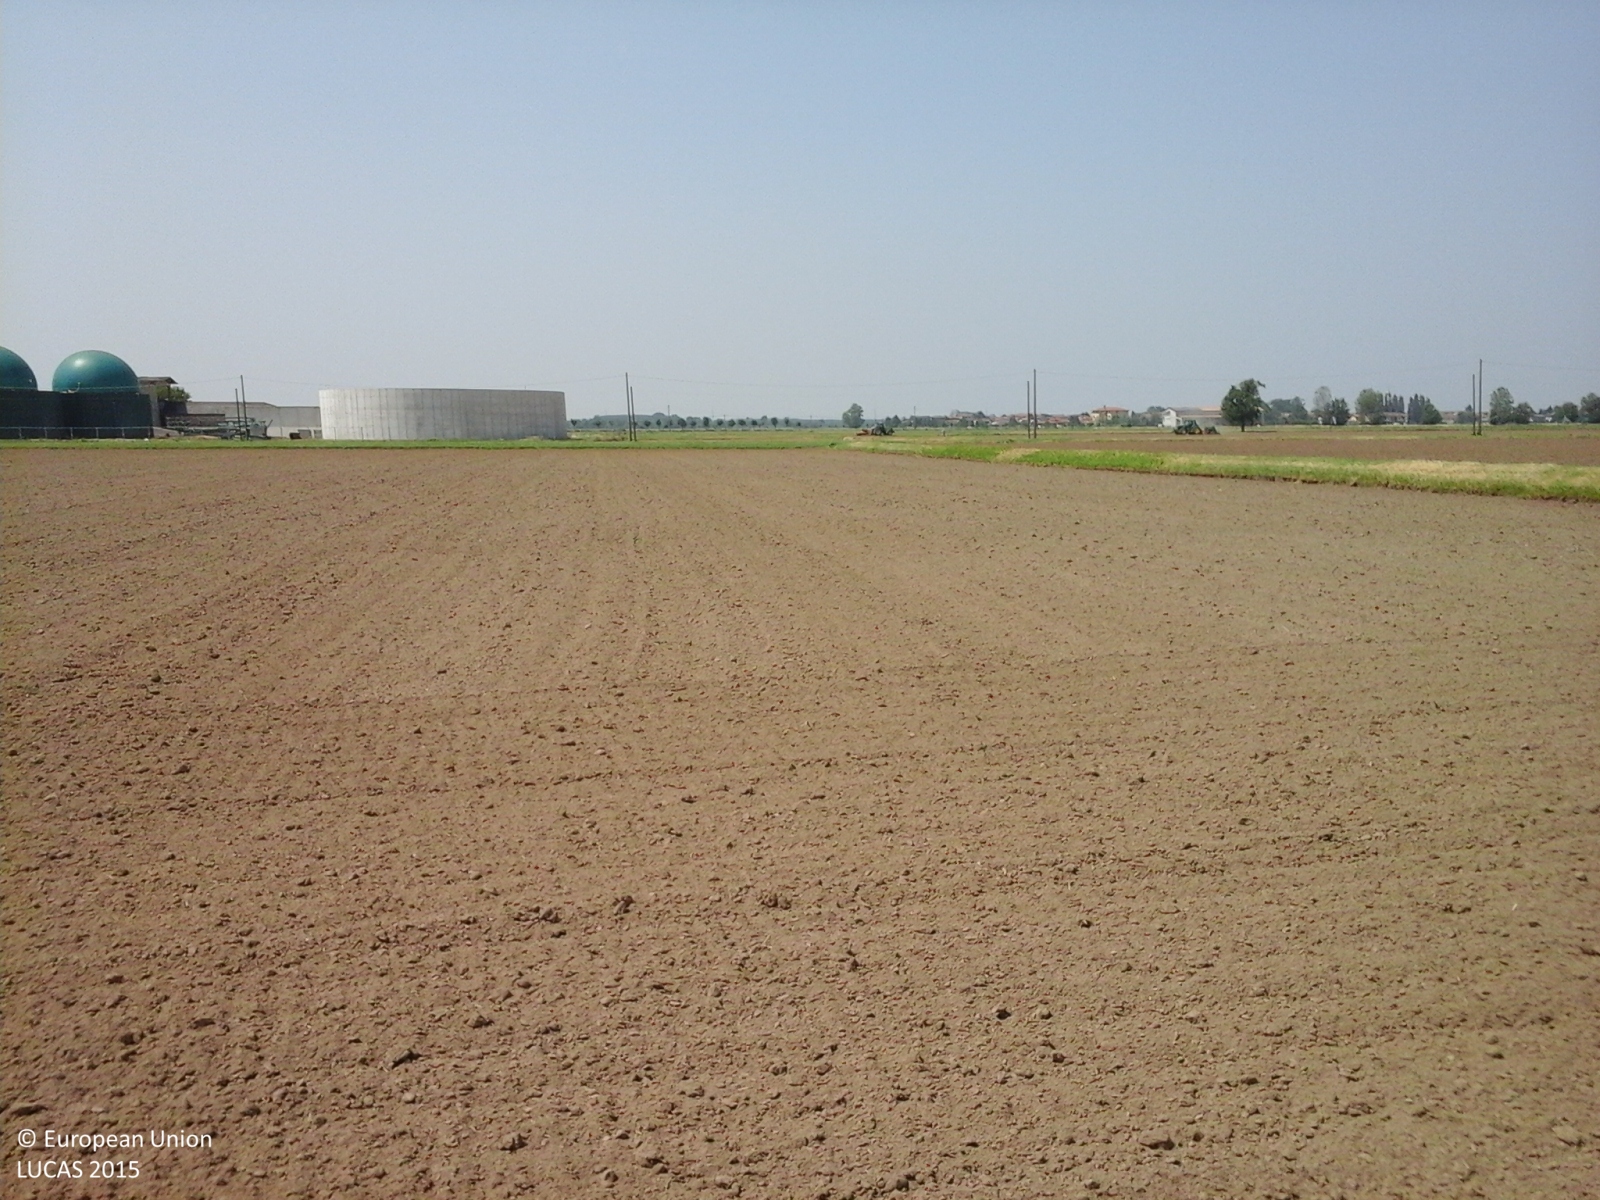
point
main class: Cropland
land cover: Rice
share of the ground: < 10 %
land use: Agriculture (excluding fallow land and kitchen gardens)
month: May
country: IT
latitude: 45.2482
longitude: 9.0970
